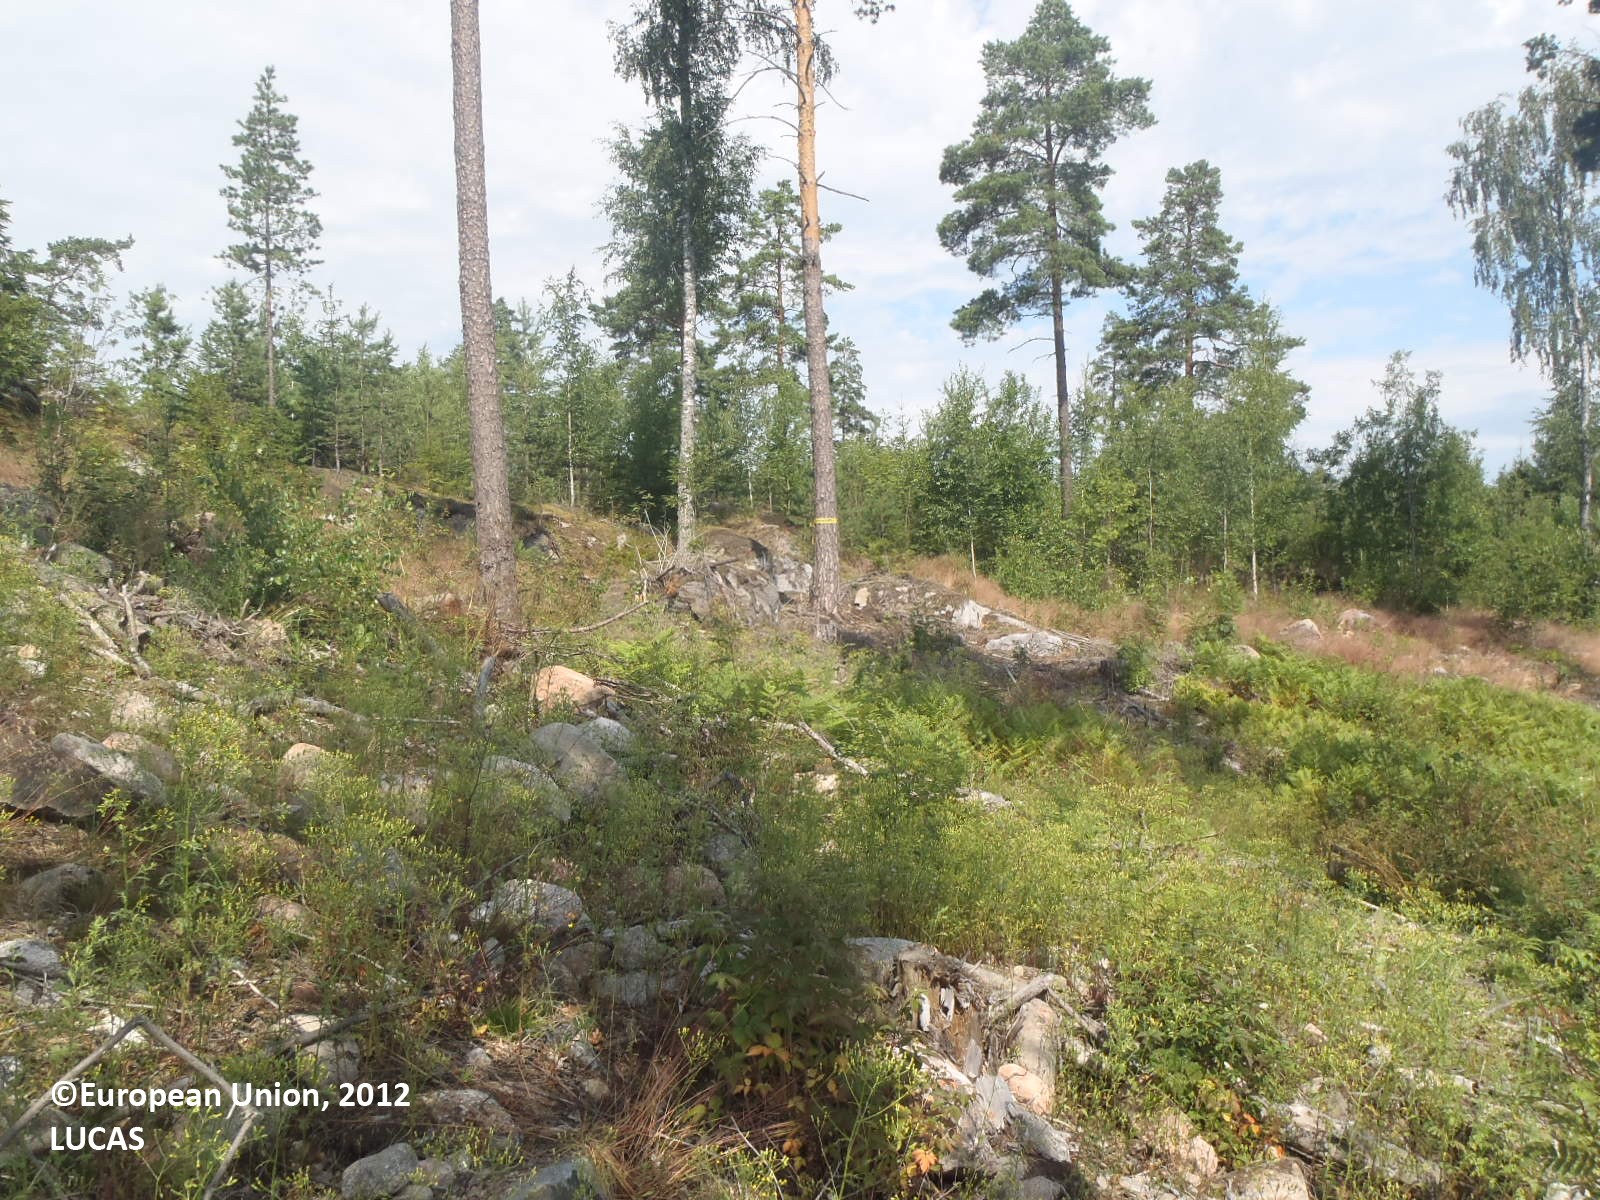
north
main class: Woodland
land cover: Pine dominated mixed woodland
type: boreal forest
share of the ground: 10 - 25 %
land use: Forestry
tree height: > 5 m
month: July
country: FI
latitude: 60.4324
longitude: 21.9997
